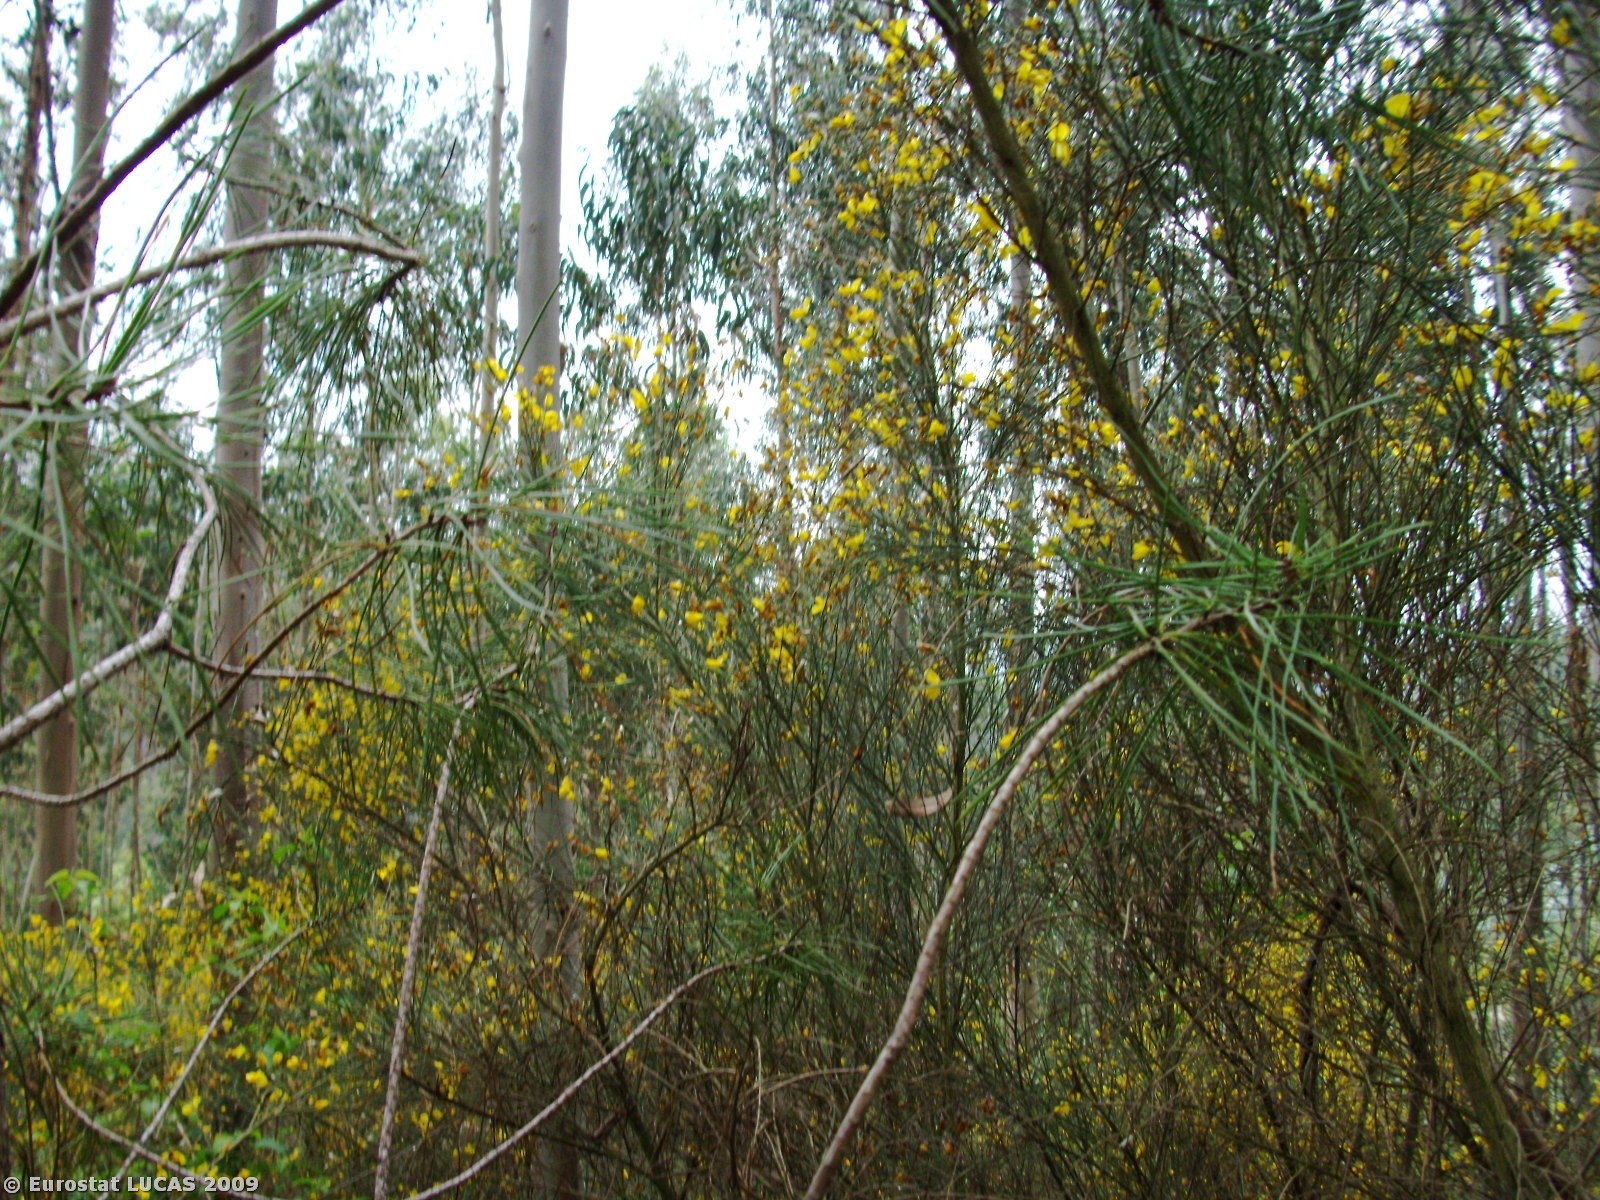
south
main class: Woodland
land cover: Broadleaved woodland
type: plantations and self-sown exotic forest
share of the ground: > 75 %
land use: Forestry
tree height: > 5 m
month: May
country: PT
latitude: 40.4259
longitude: -8.3427
